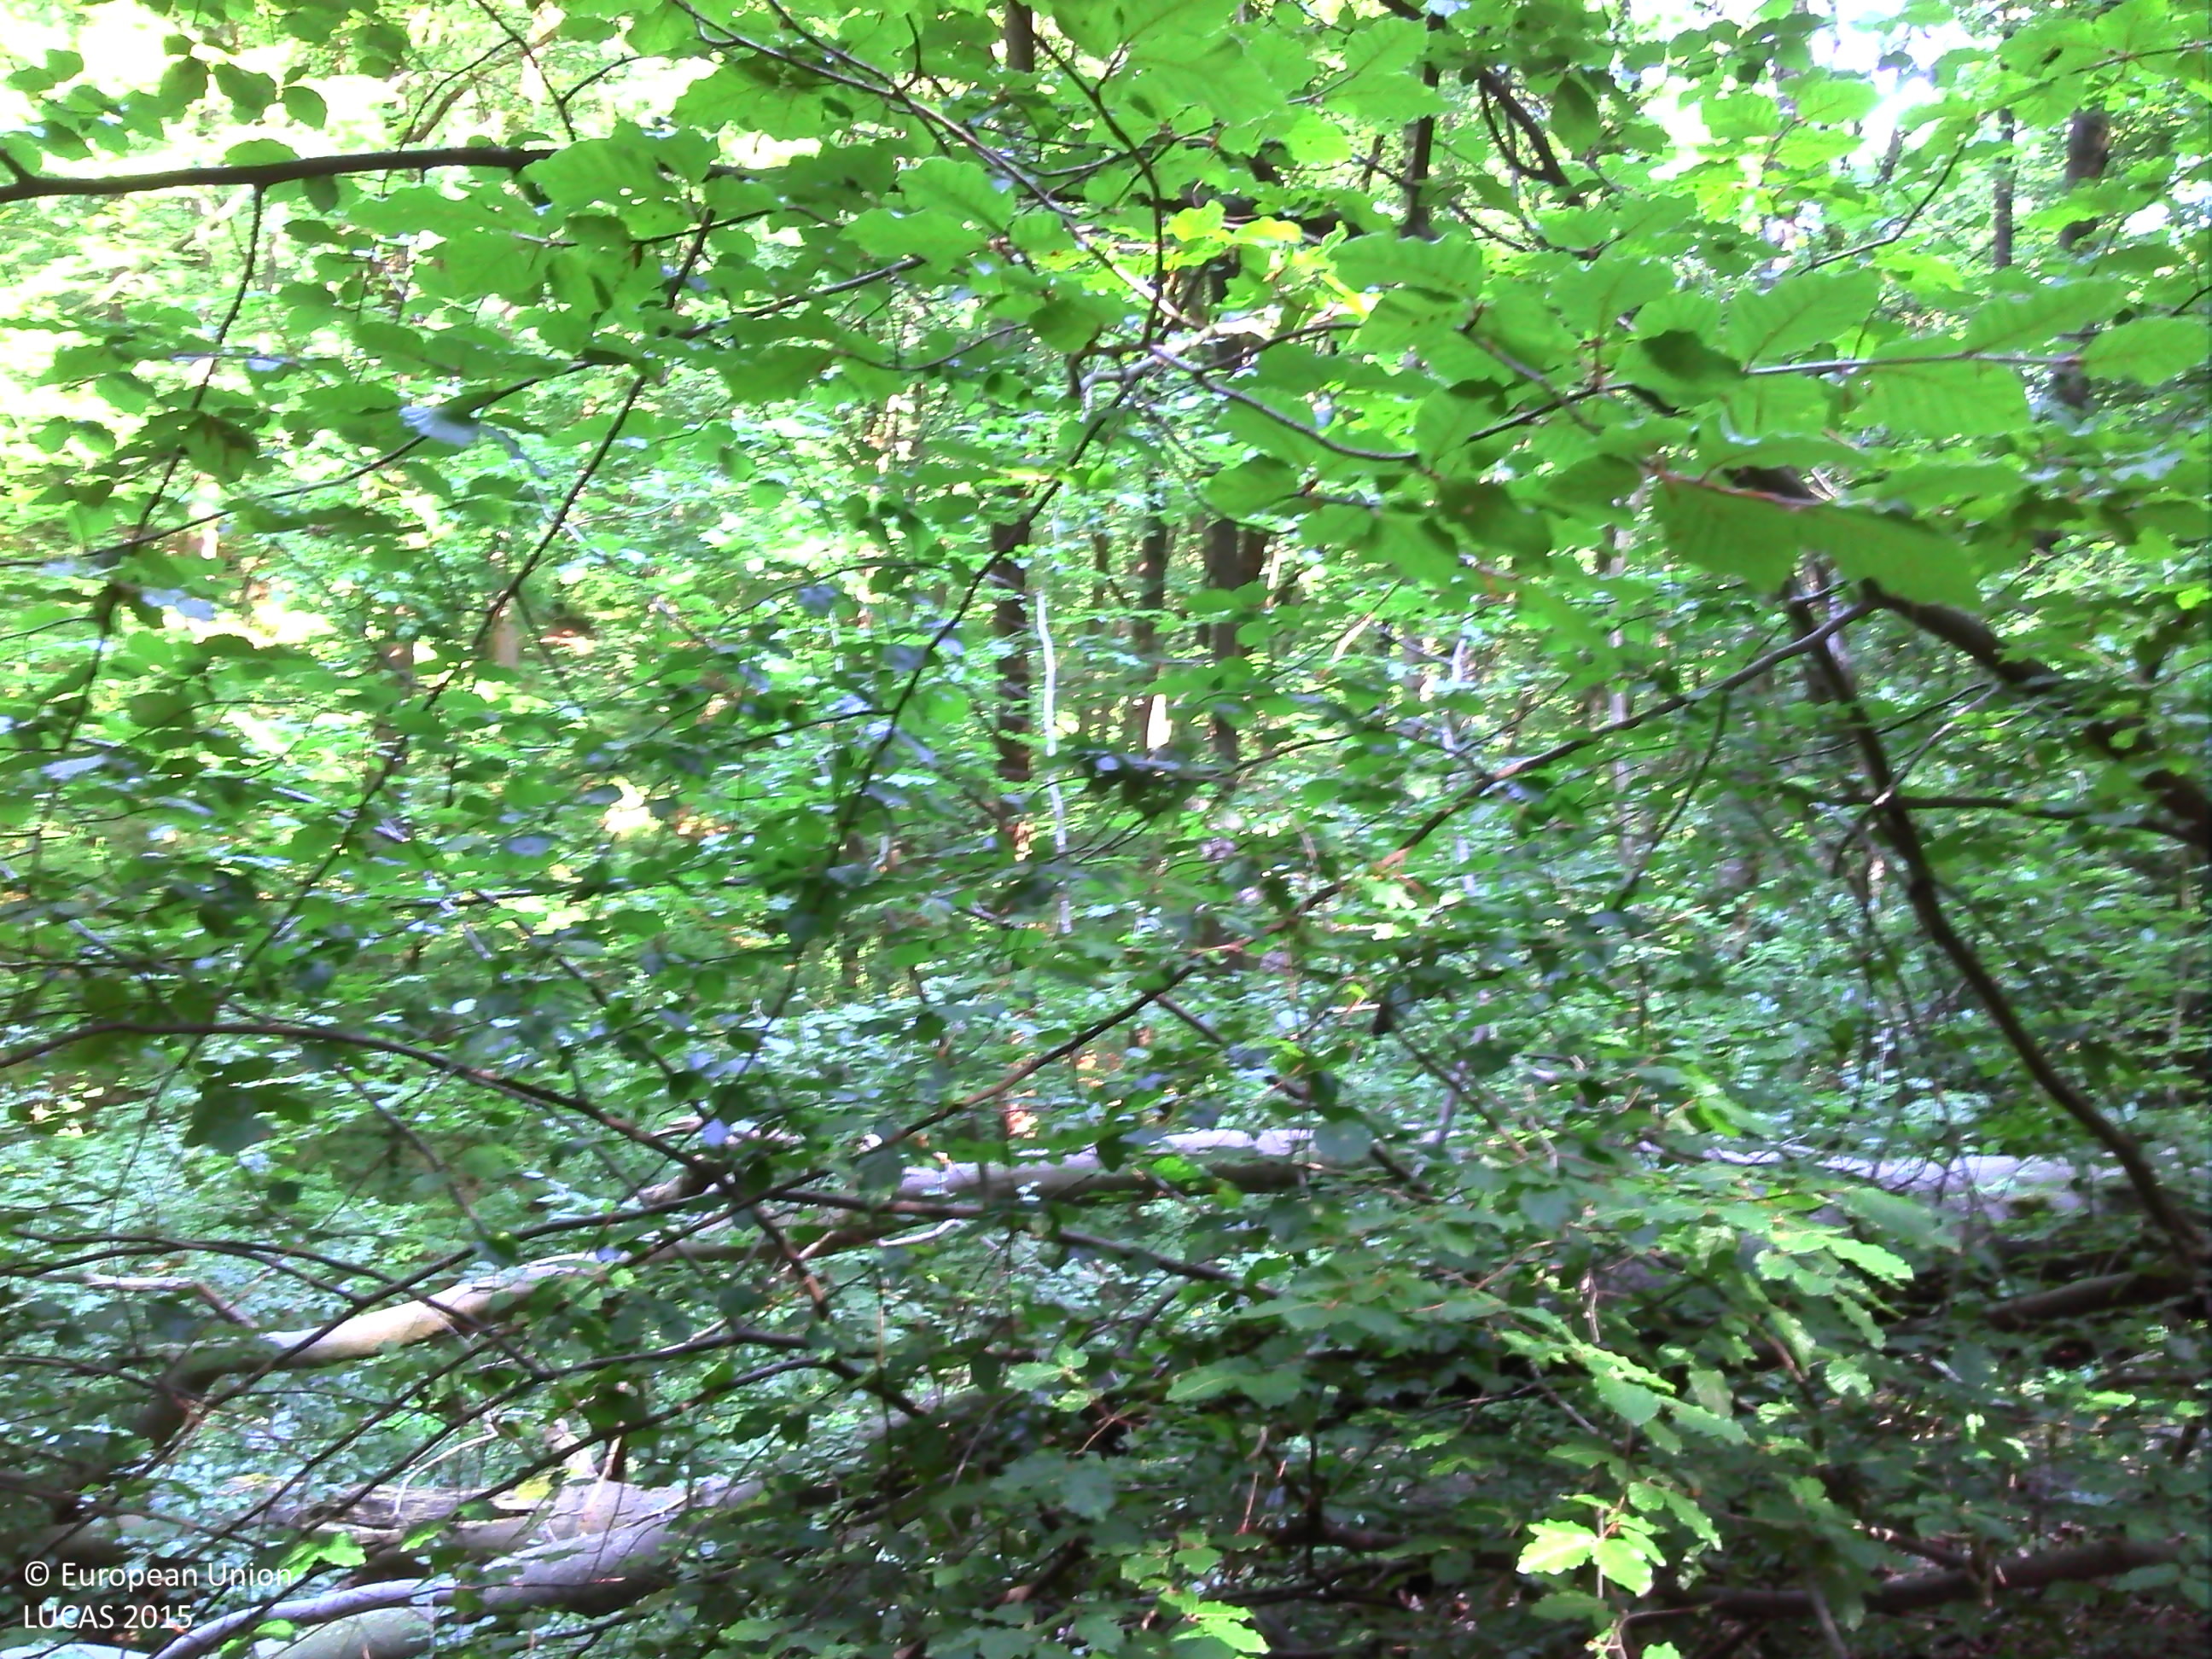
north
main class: Woodland
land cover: Broadleaved woodland
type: acidophilous oak and oak-birch forest
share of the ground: > 75 %
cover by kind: broadleaved forest trees 90 %, herbaceous plants 10 %
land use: Forestry
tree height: > 5 m
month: July
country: BE
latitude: 50.5552
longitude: 5.7501
